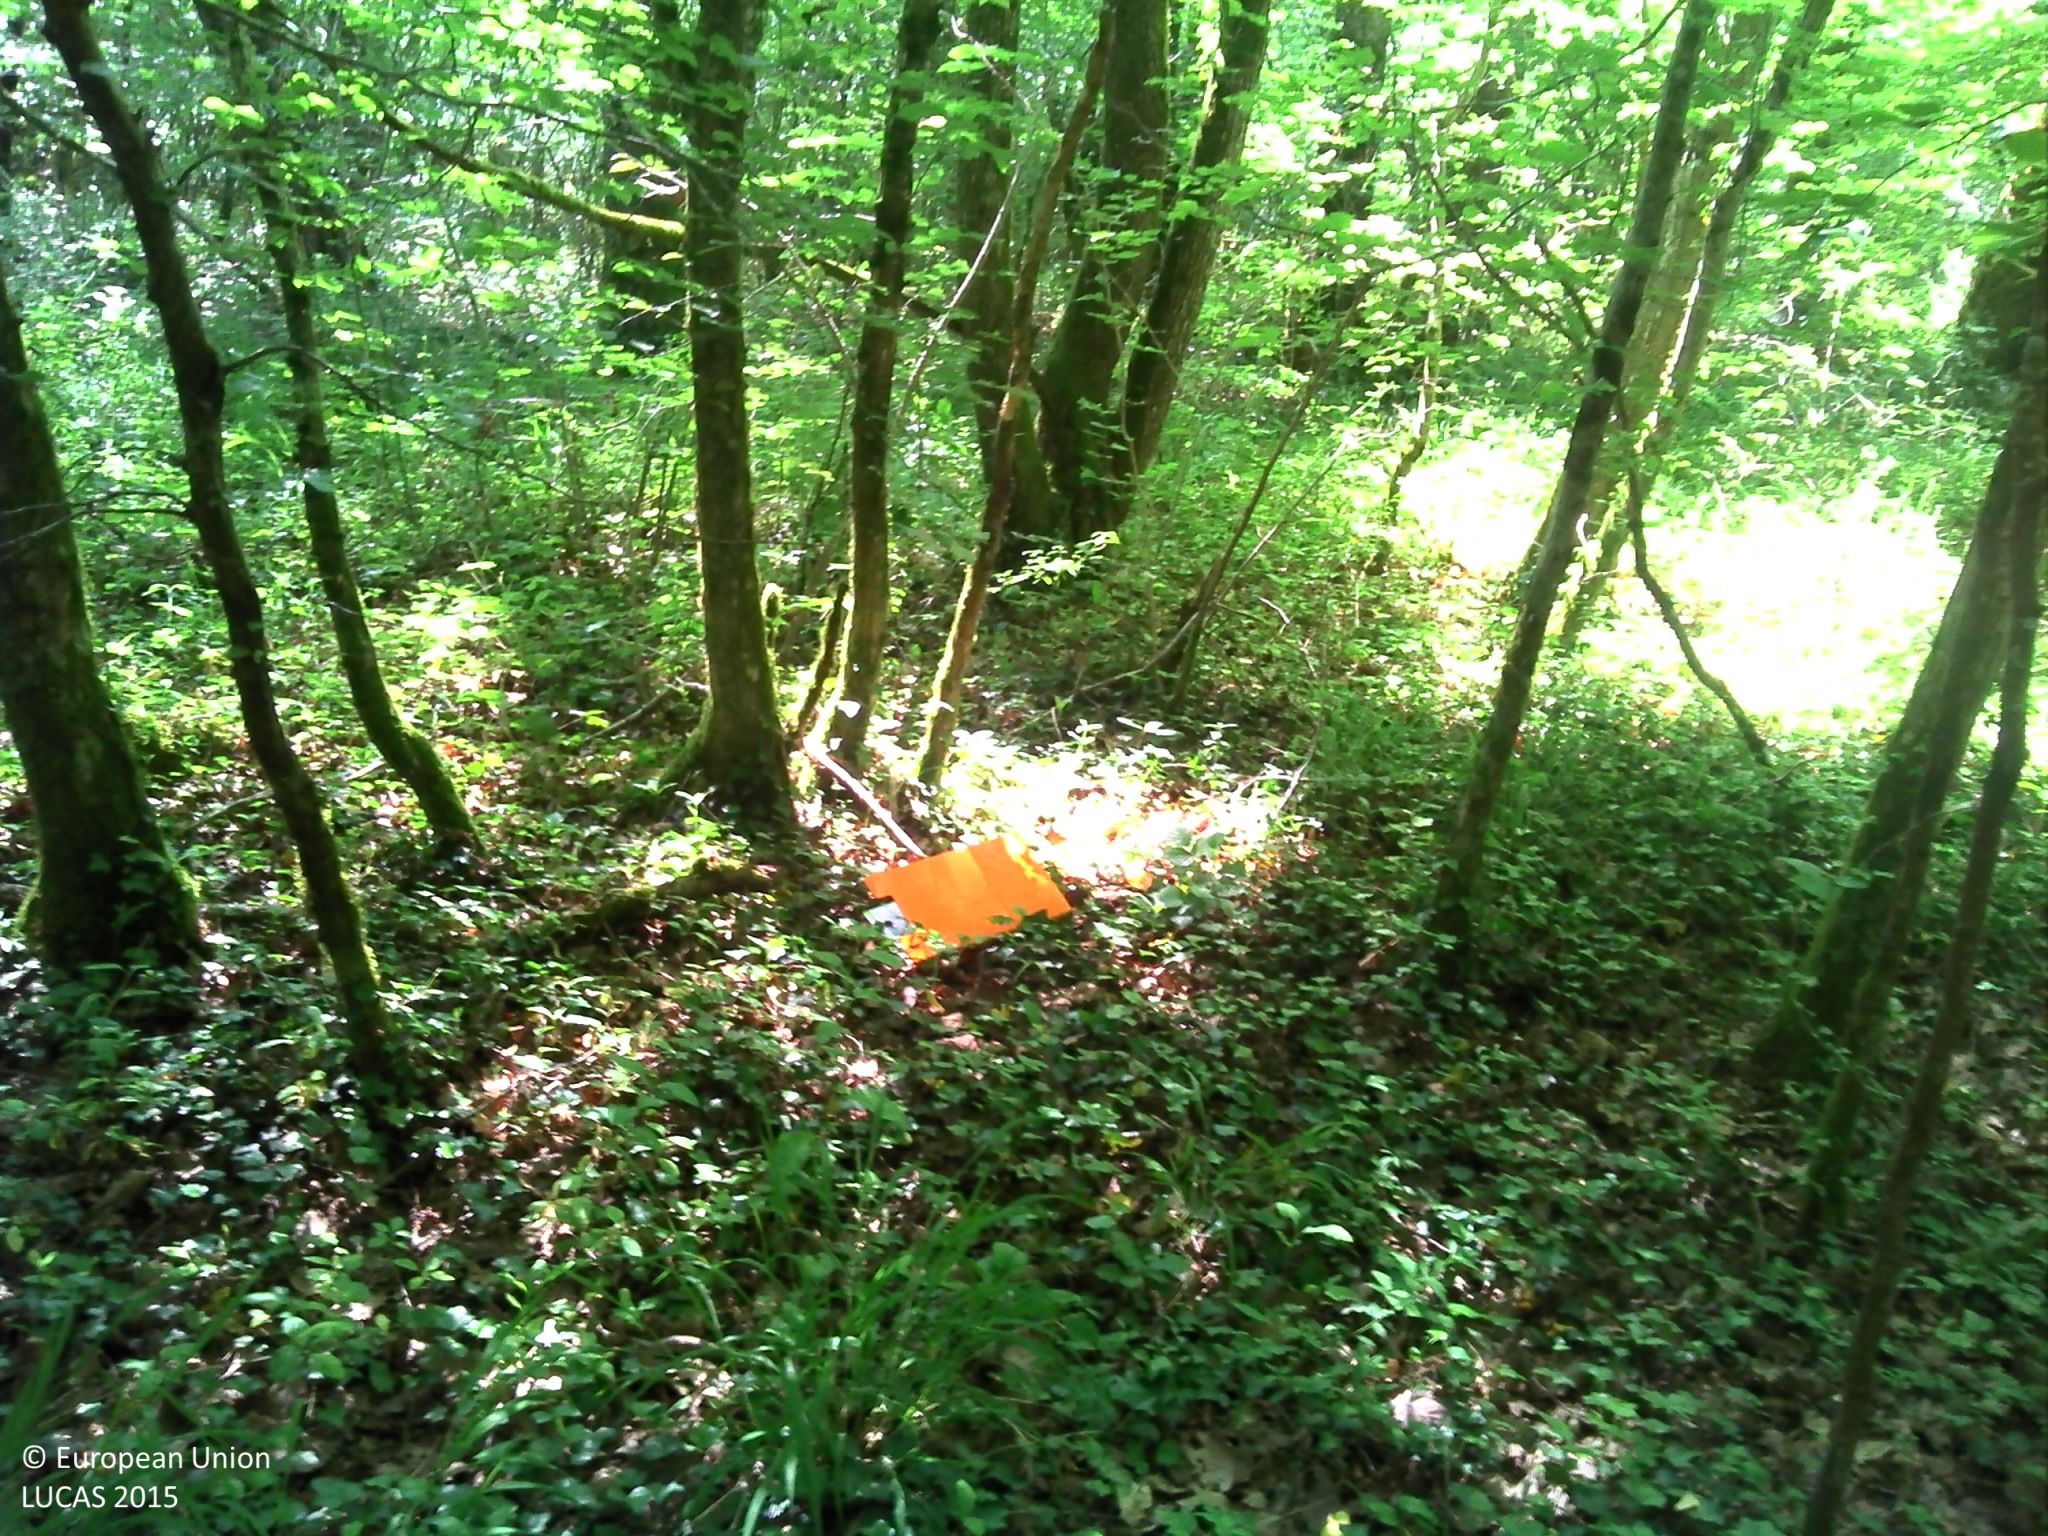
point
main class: Woodland
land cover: Broadleaved woodland
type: beech forest
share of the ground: > 75 %
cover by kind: broadleaved forest trees 90 %, herbaceous plants 10 %
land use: Forestry
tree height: > 5 m
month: June
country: FR
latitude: 47.5583
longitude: 6.0542
